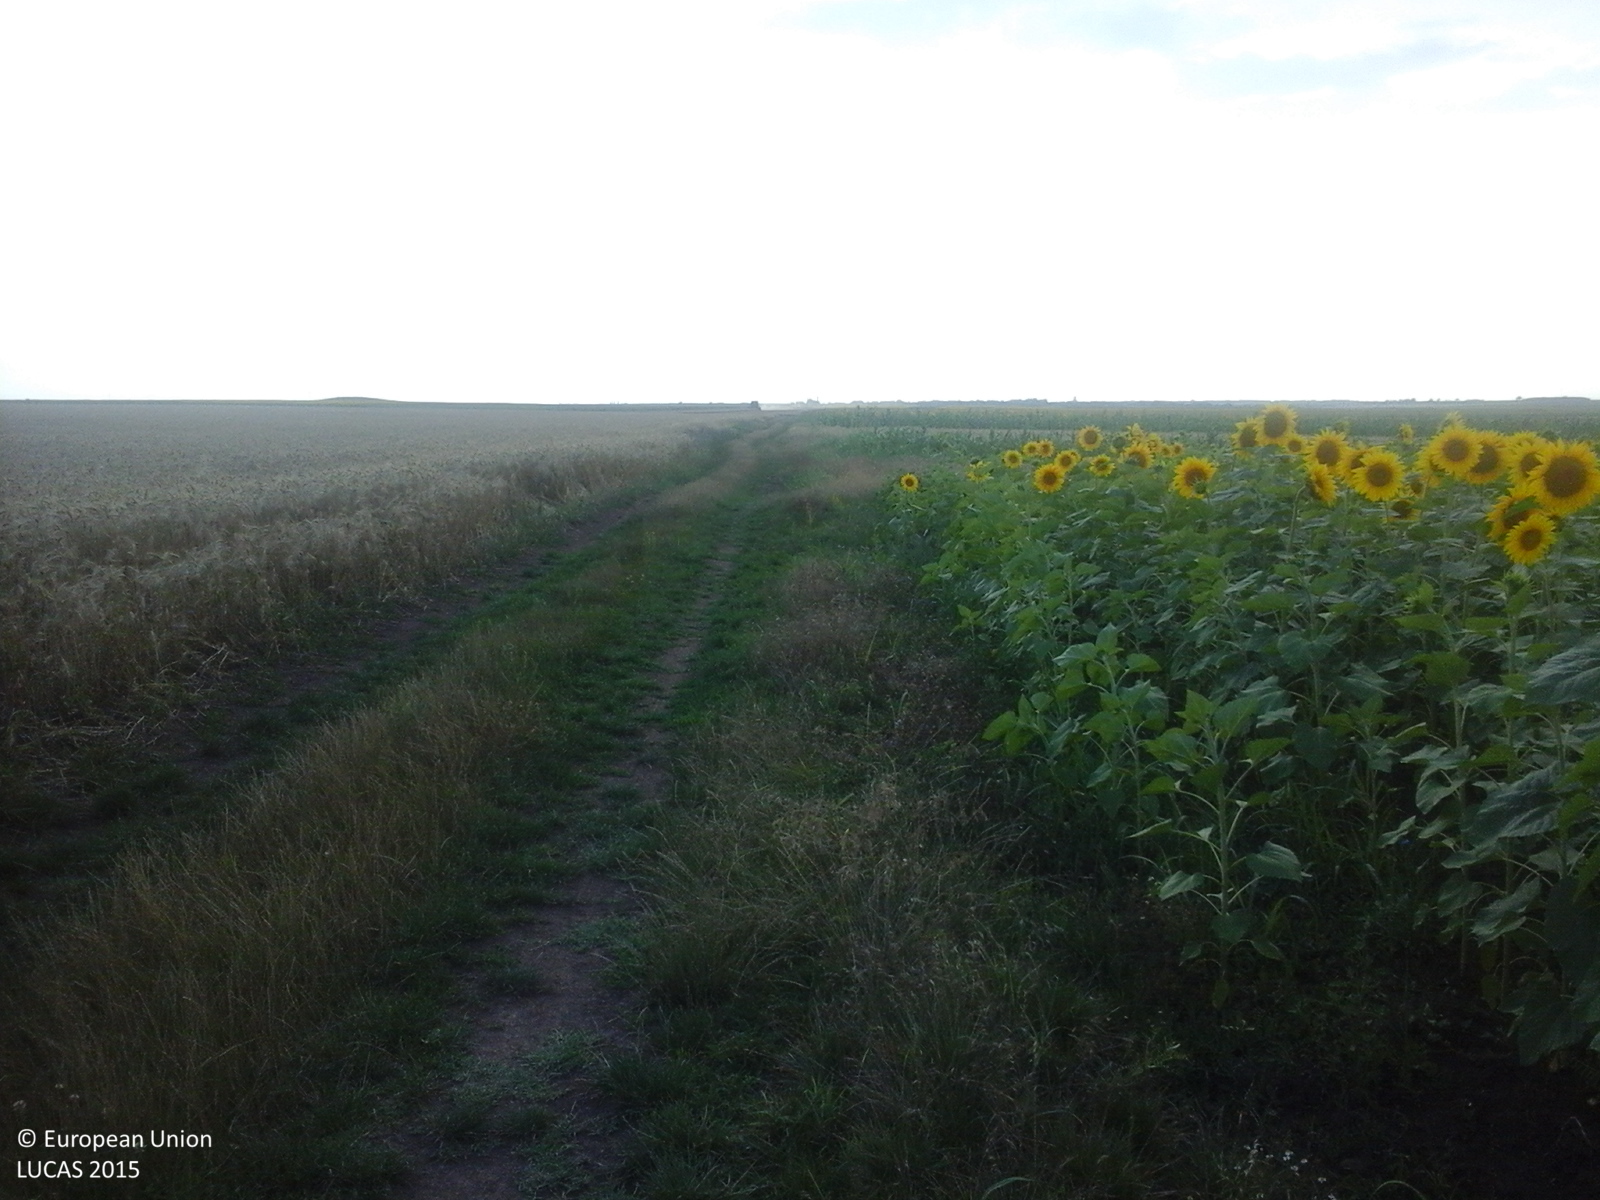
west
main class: Cropland
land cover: Sunflower
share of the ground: > 75 %
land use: Agriculture (excluding fallow land and kitchen gardens)
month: July
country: RO
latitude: 44.0385
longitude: 24.3779
